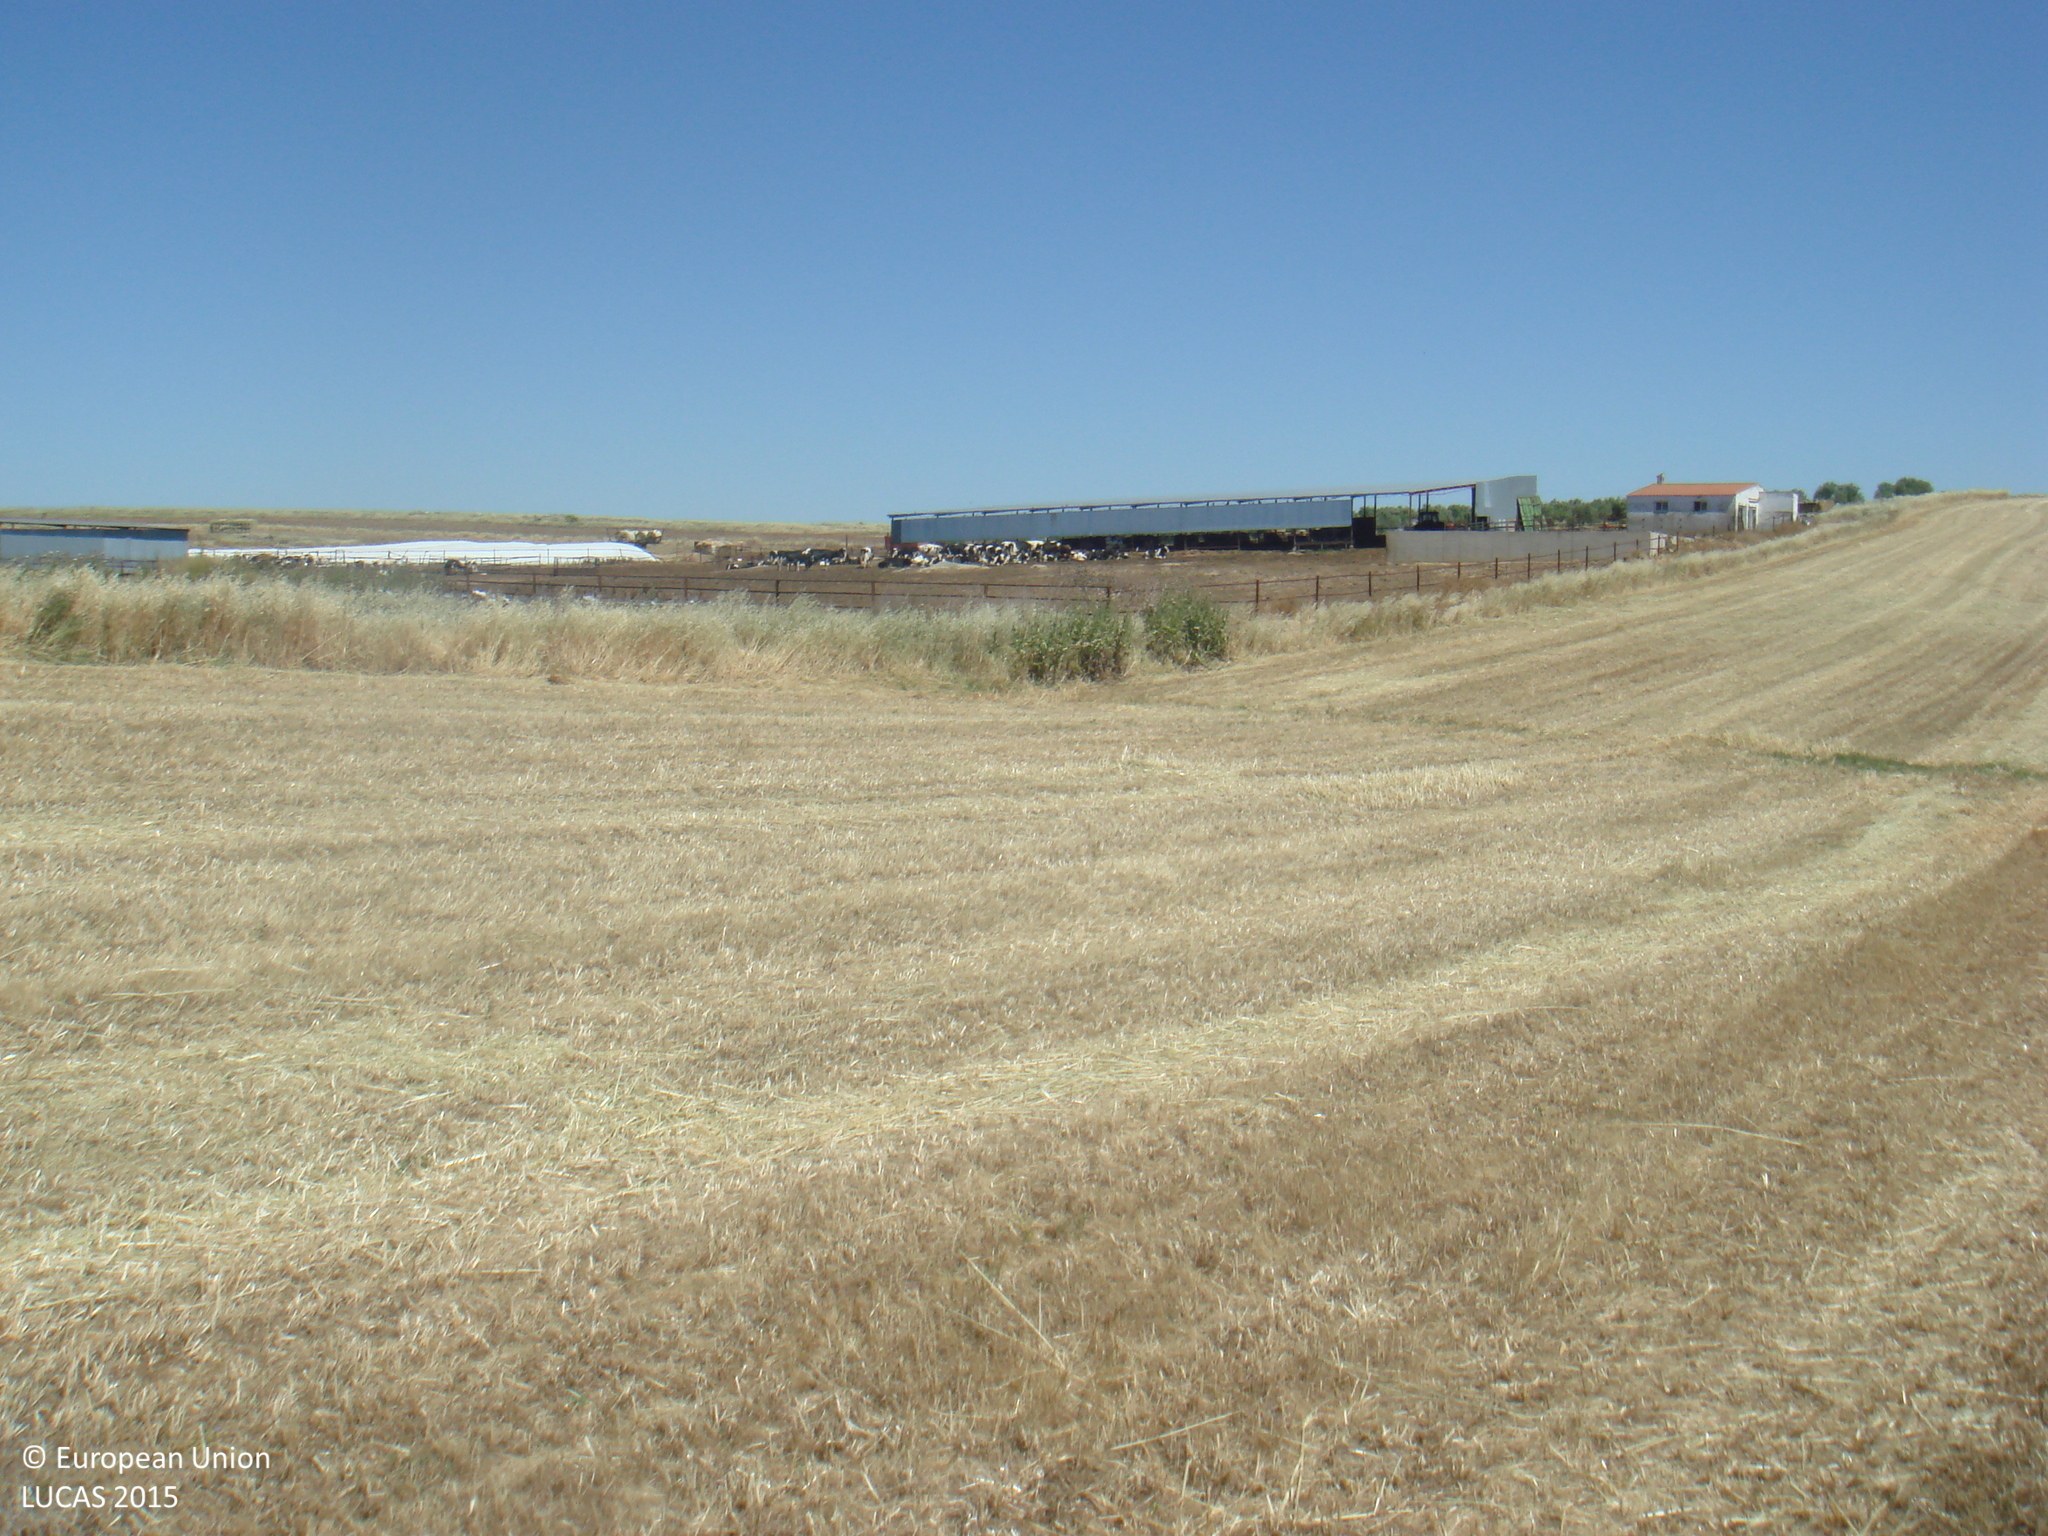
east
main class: Cropland
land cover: Barley
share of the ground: > 75 %
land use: Agriculture (excluding fallow land and kitchen gardens)
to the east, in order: Barley; Grass margins; Tracks; Grass margins; Grassland without tree/shrub cover; Fences; Other bare soil; Fences; Grassland without tree/shrub cover; Tracks; Grassland without tree/shrub cover
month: May
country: ES
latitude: 38.5691
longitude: -5.1466
